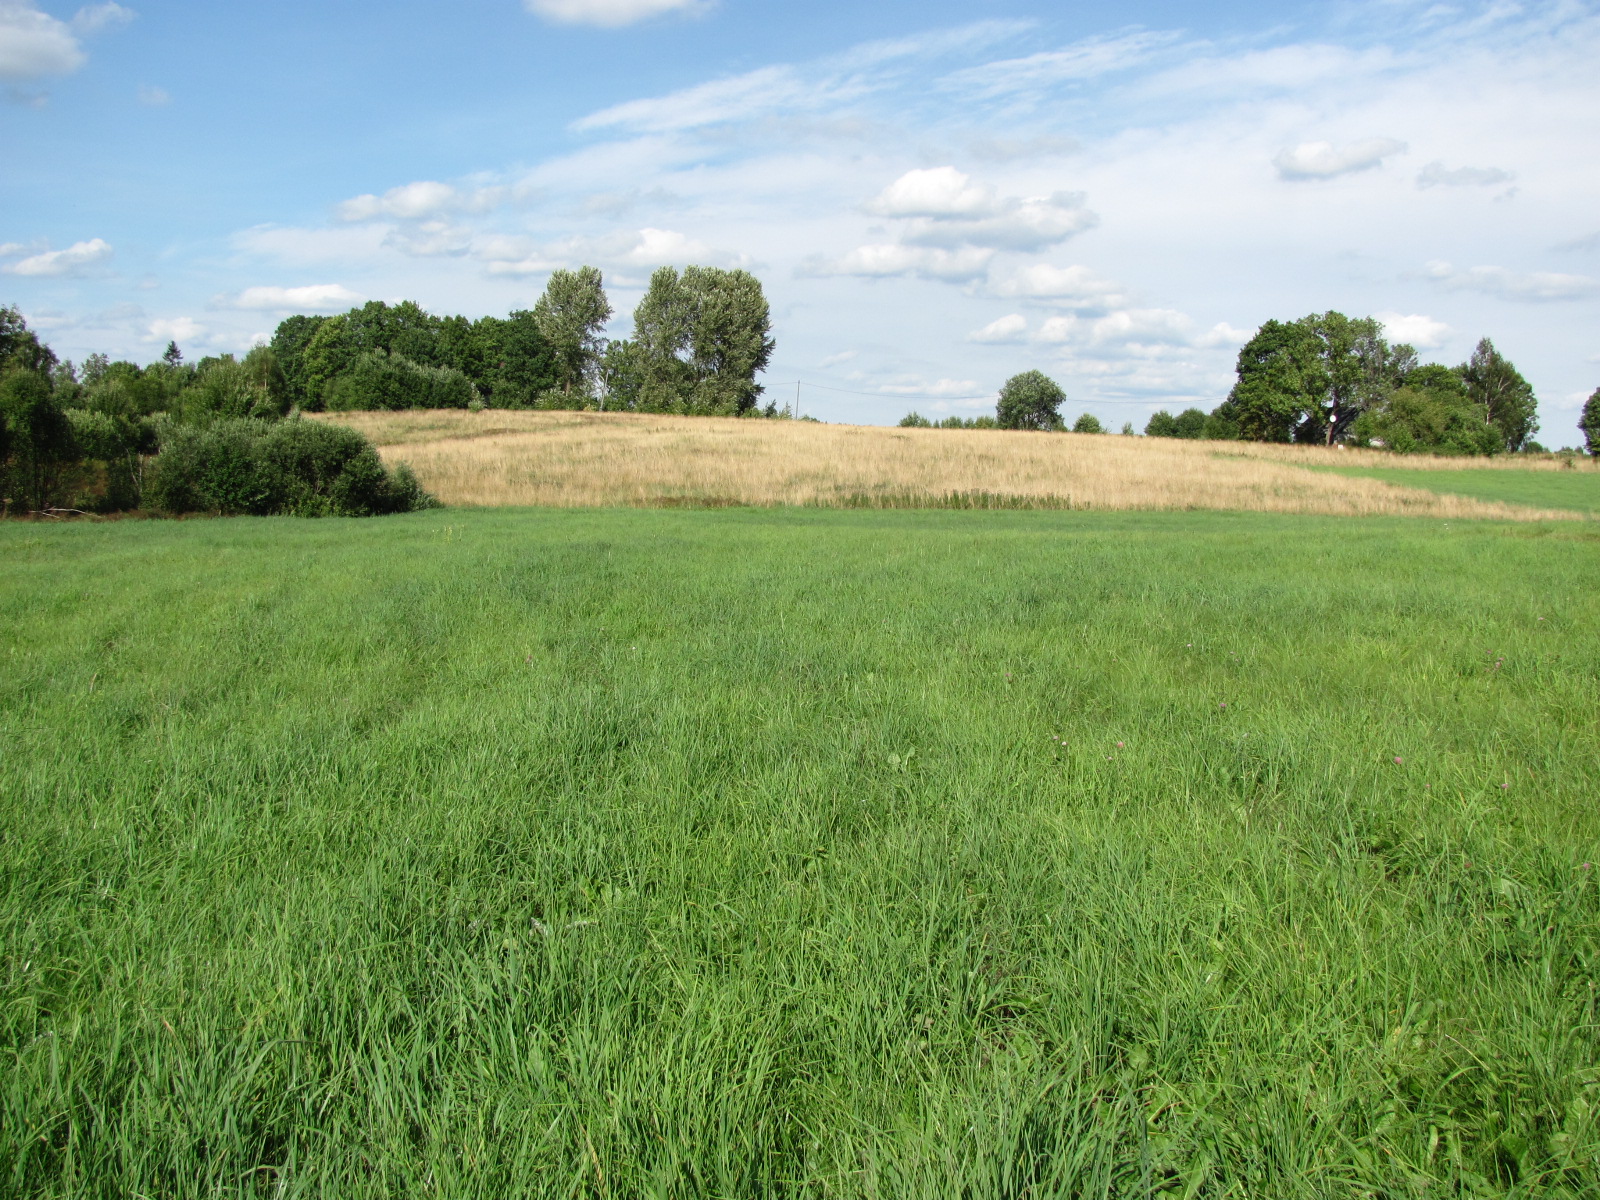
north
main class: Grassland
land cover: Grassland without tree/shrub cover
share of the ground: > 75 %
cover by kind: herbaceous plants 100 %
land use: Agriculture (excluding fallow land and kitchen gardens)
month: August
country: LV
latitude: 56.9904
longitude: 25.2702
